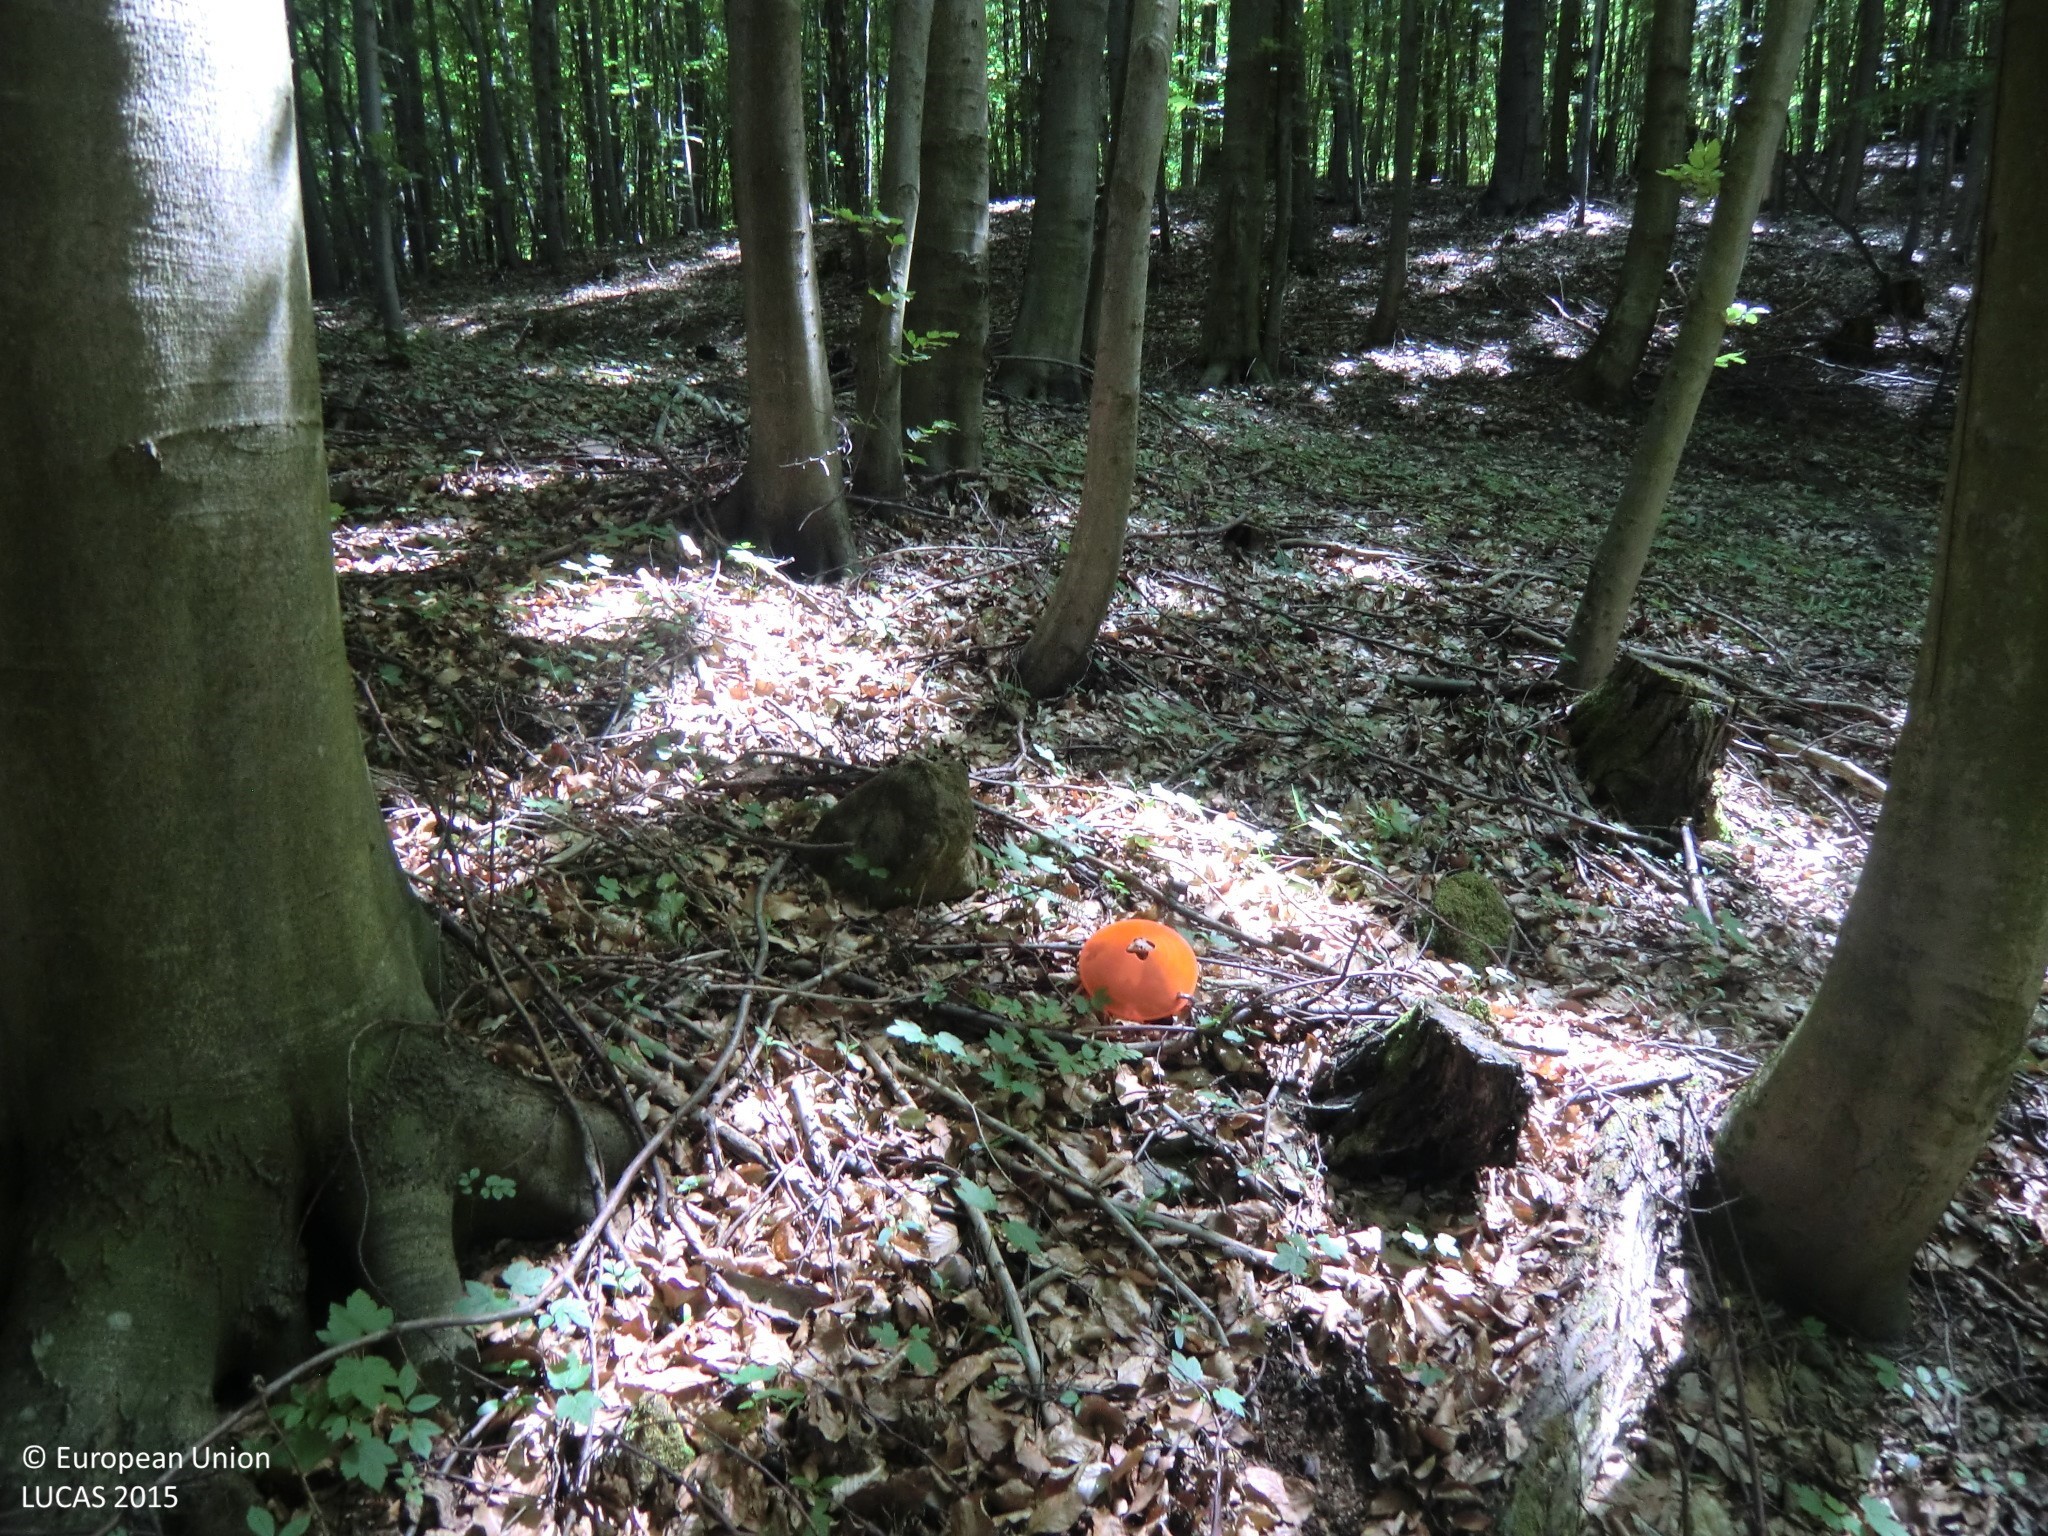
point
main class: Woodland
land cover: Broadleaved woodland
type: beech forest
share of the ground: > 75 %
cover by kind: broadleaved forest trees 80 %, coniferous forest trees 10 %, unconsolidated bare surface 10 %
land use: Forestry
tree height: > 5 m
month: May
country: AT
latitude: 48.0600
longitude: 15.3017
